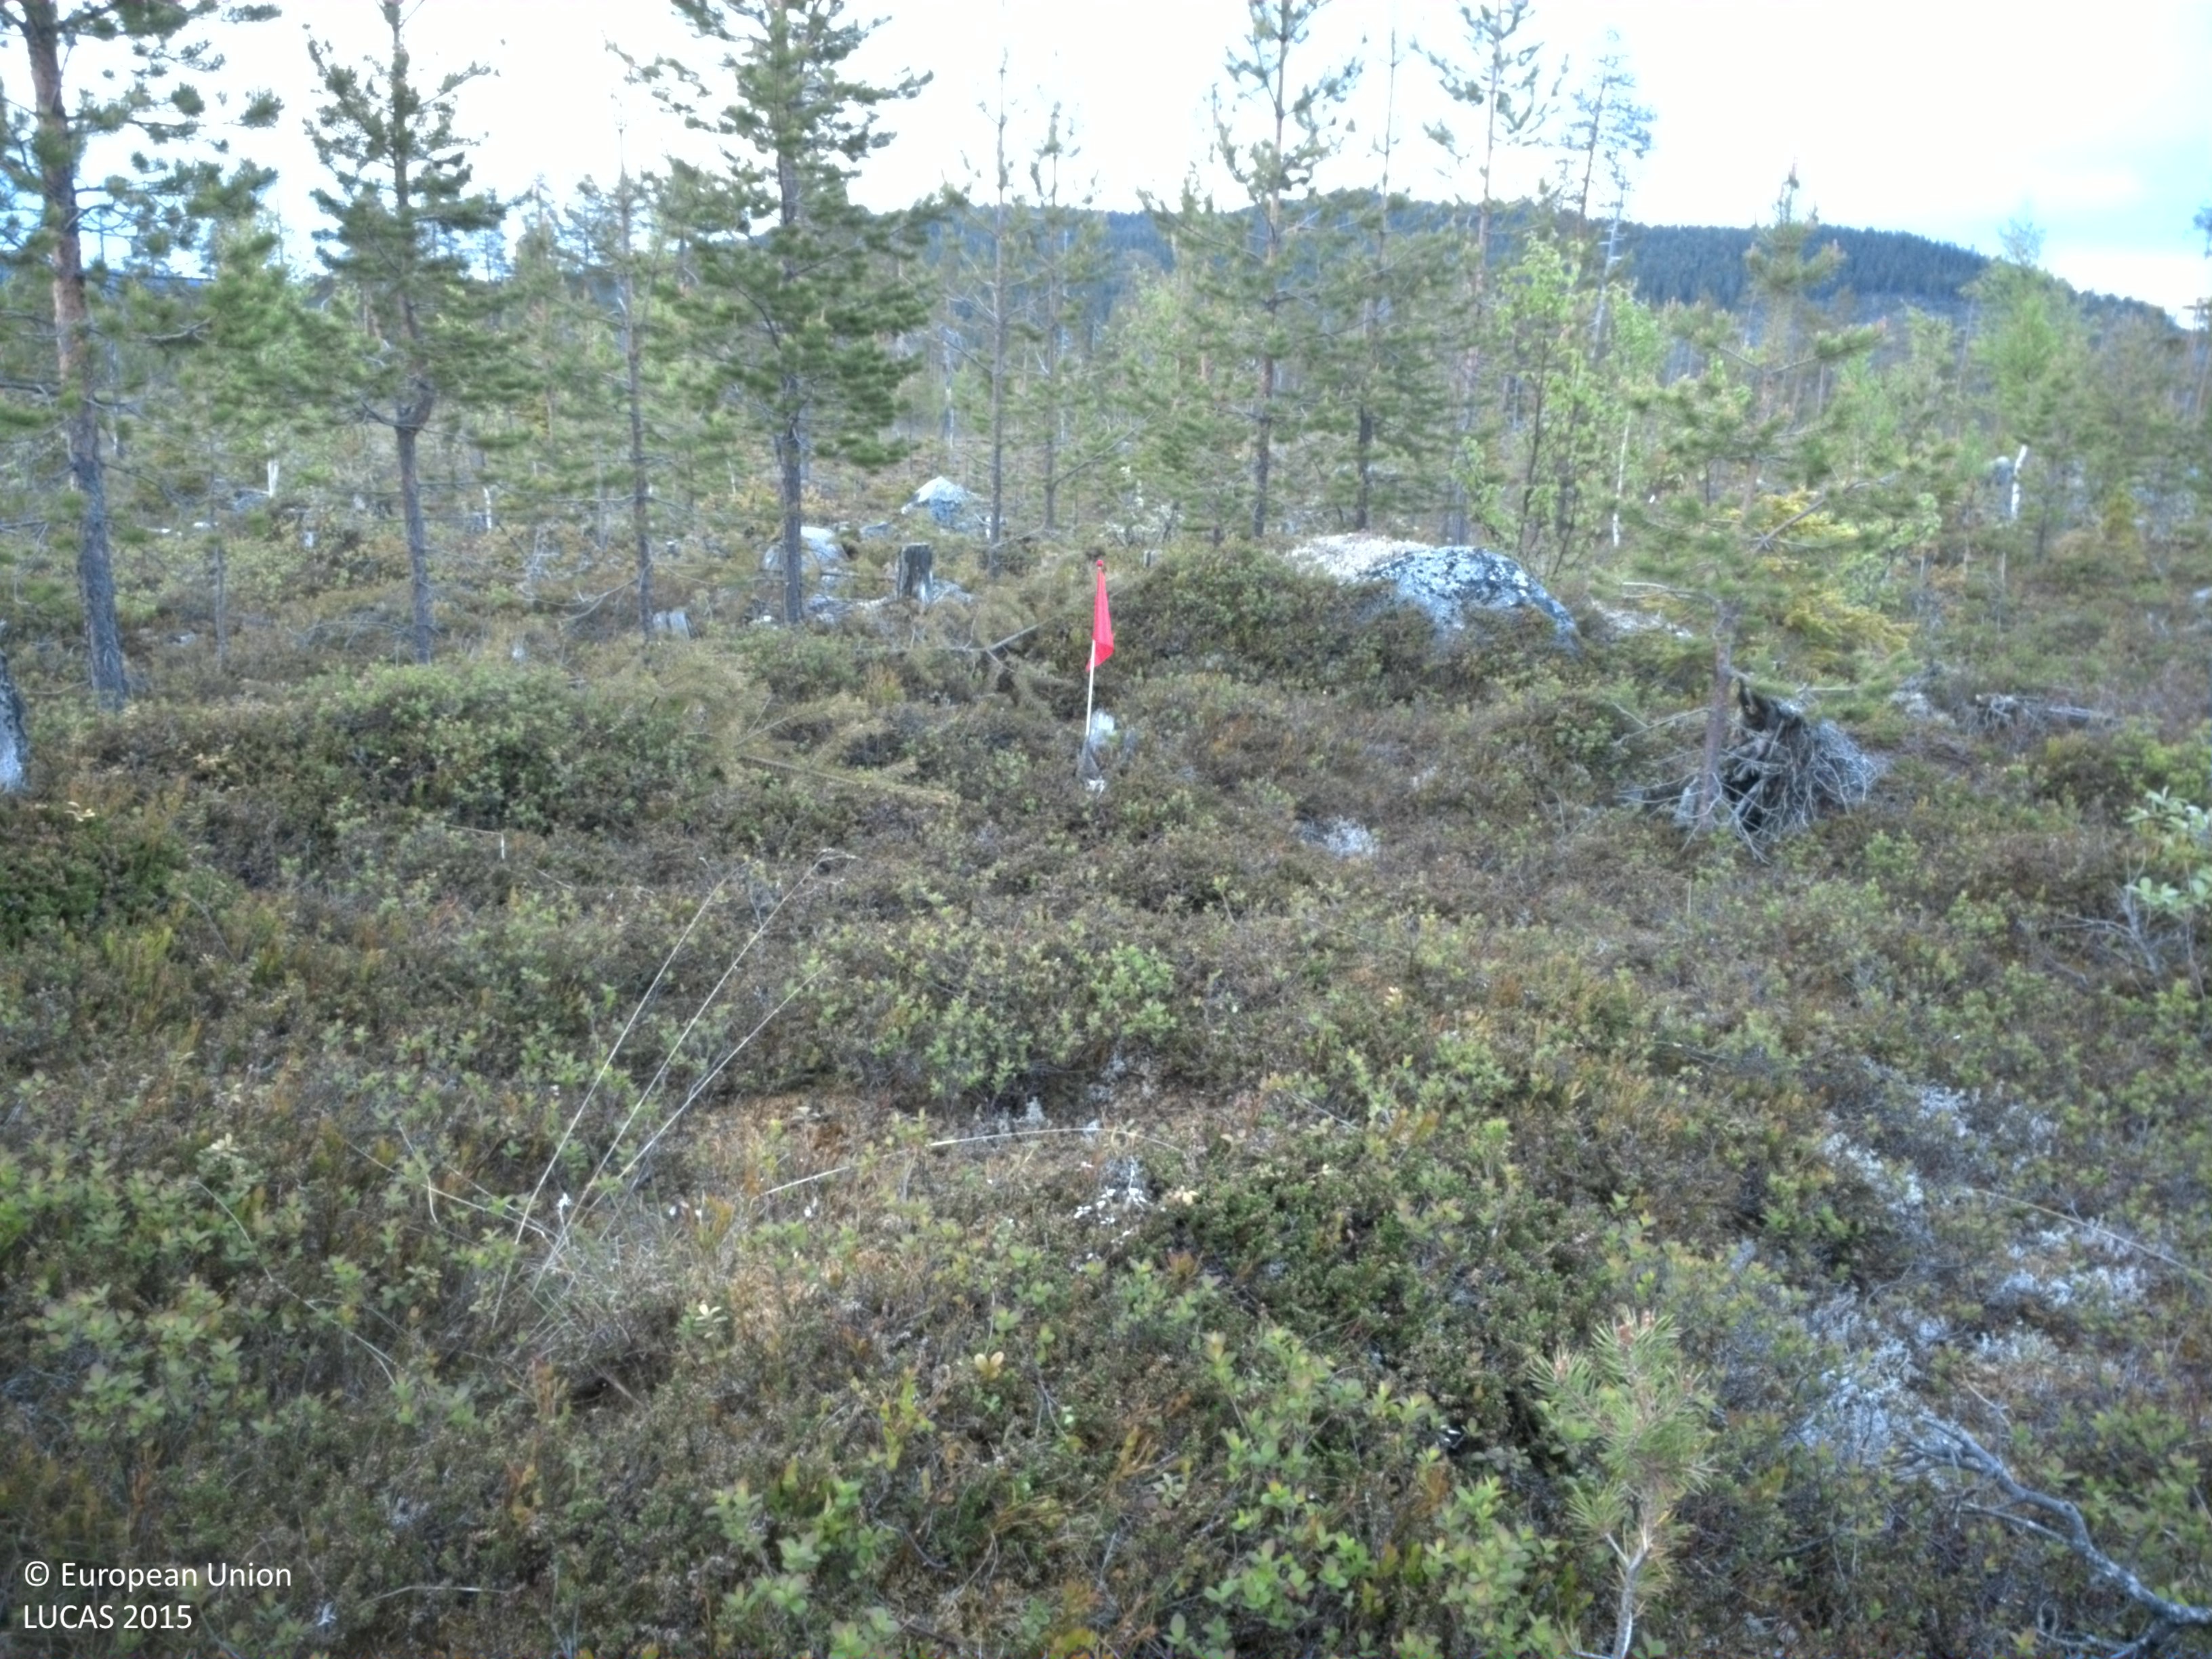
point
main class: Woodland
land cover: Pine dominated coniferous woodland
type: boreal forest
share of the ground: 10 - 25 %
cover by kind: shrubs 70 %, coniferous forest trees 20 %, broadleaved forest trees 5 %, consolidated bare surface 5 %
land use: Forestry
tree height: < 5 m
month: June
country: SE
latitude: 65.9910
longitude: 19.8041
